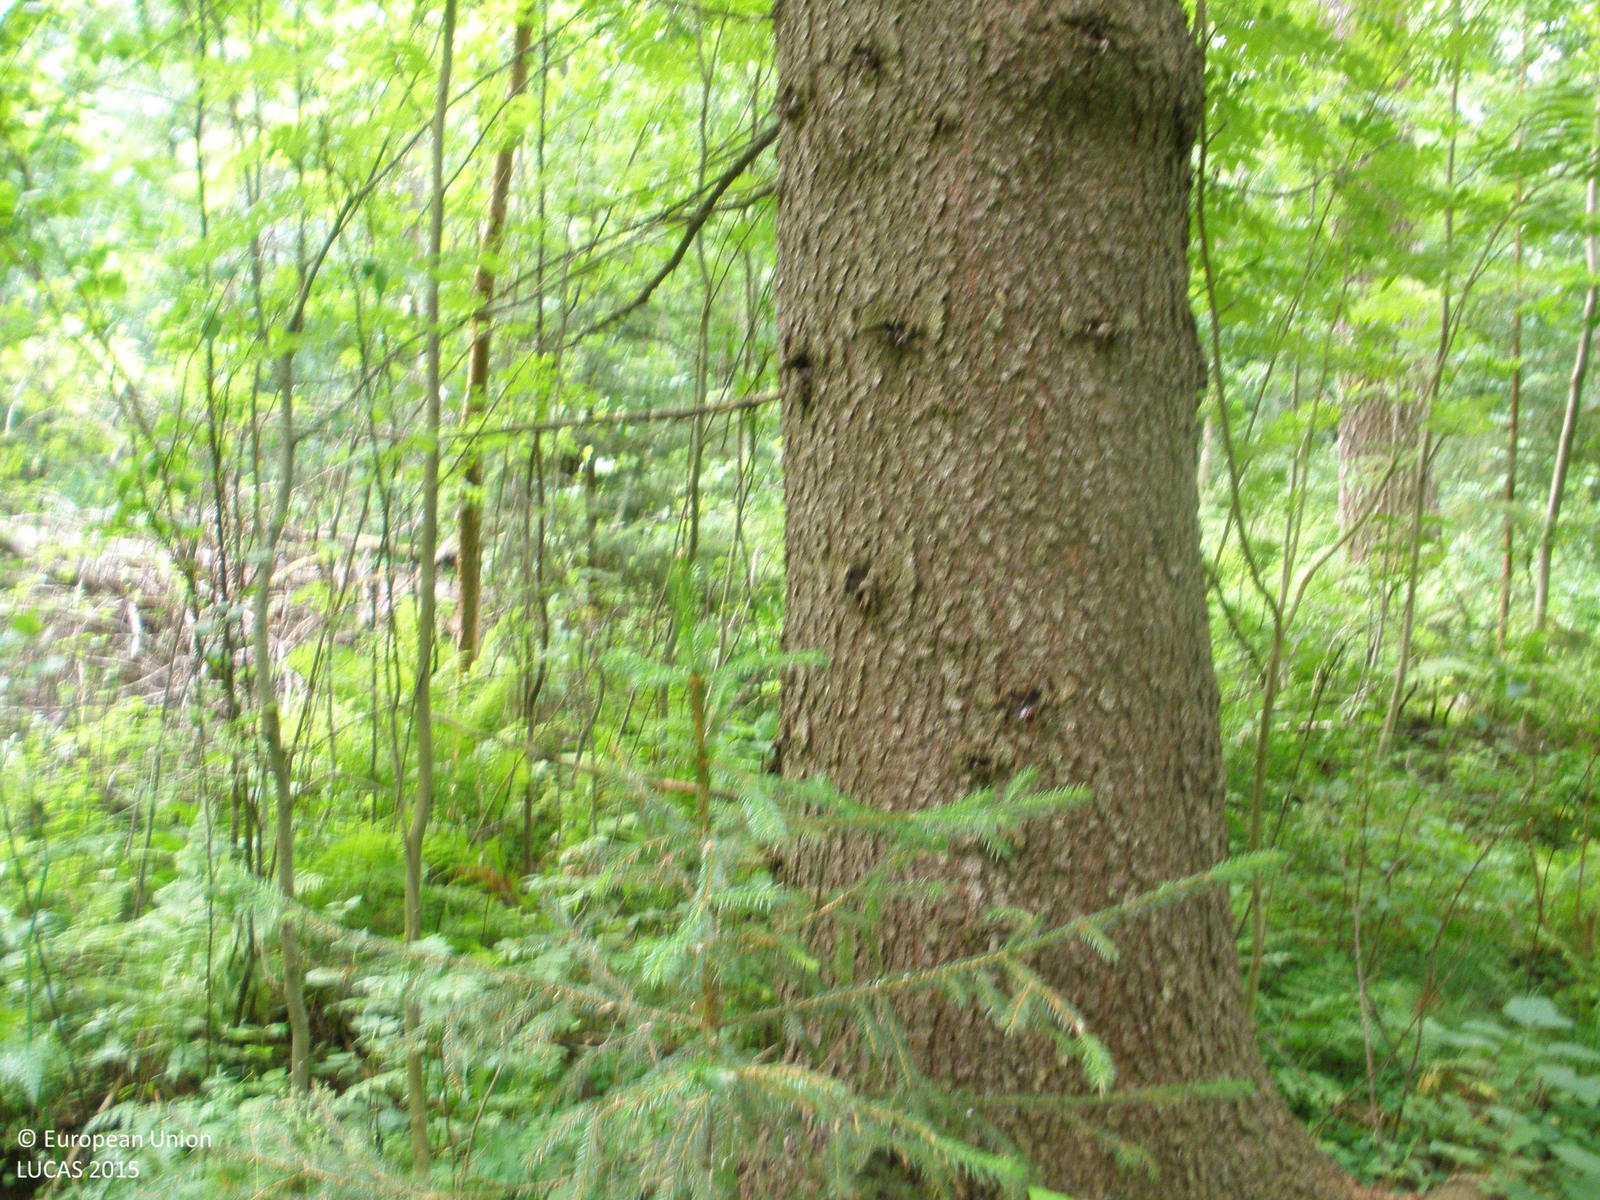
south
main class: Woodland
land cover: Broadleaved woodland
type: boreal forest
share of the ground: > 75 %
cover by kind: broadleaved forest trees 80 %, shrubs 10 %, coniferous forest trees 5 %, herbaceous plants 5 %
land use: Forestry
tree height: > 5 m
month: July
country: FI
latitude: 61.4343
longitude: 24.0568
